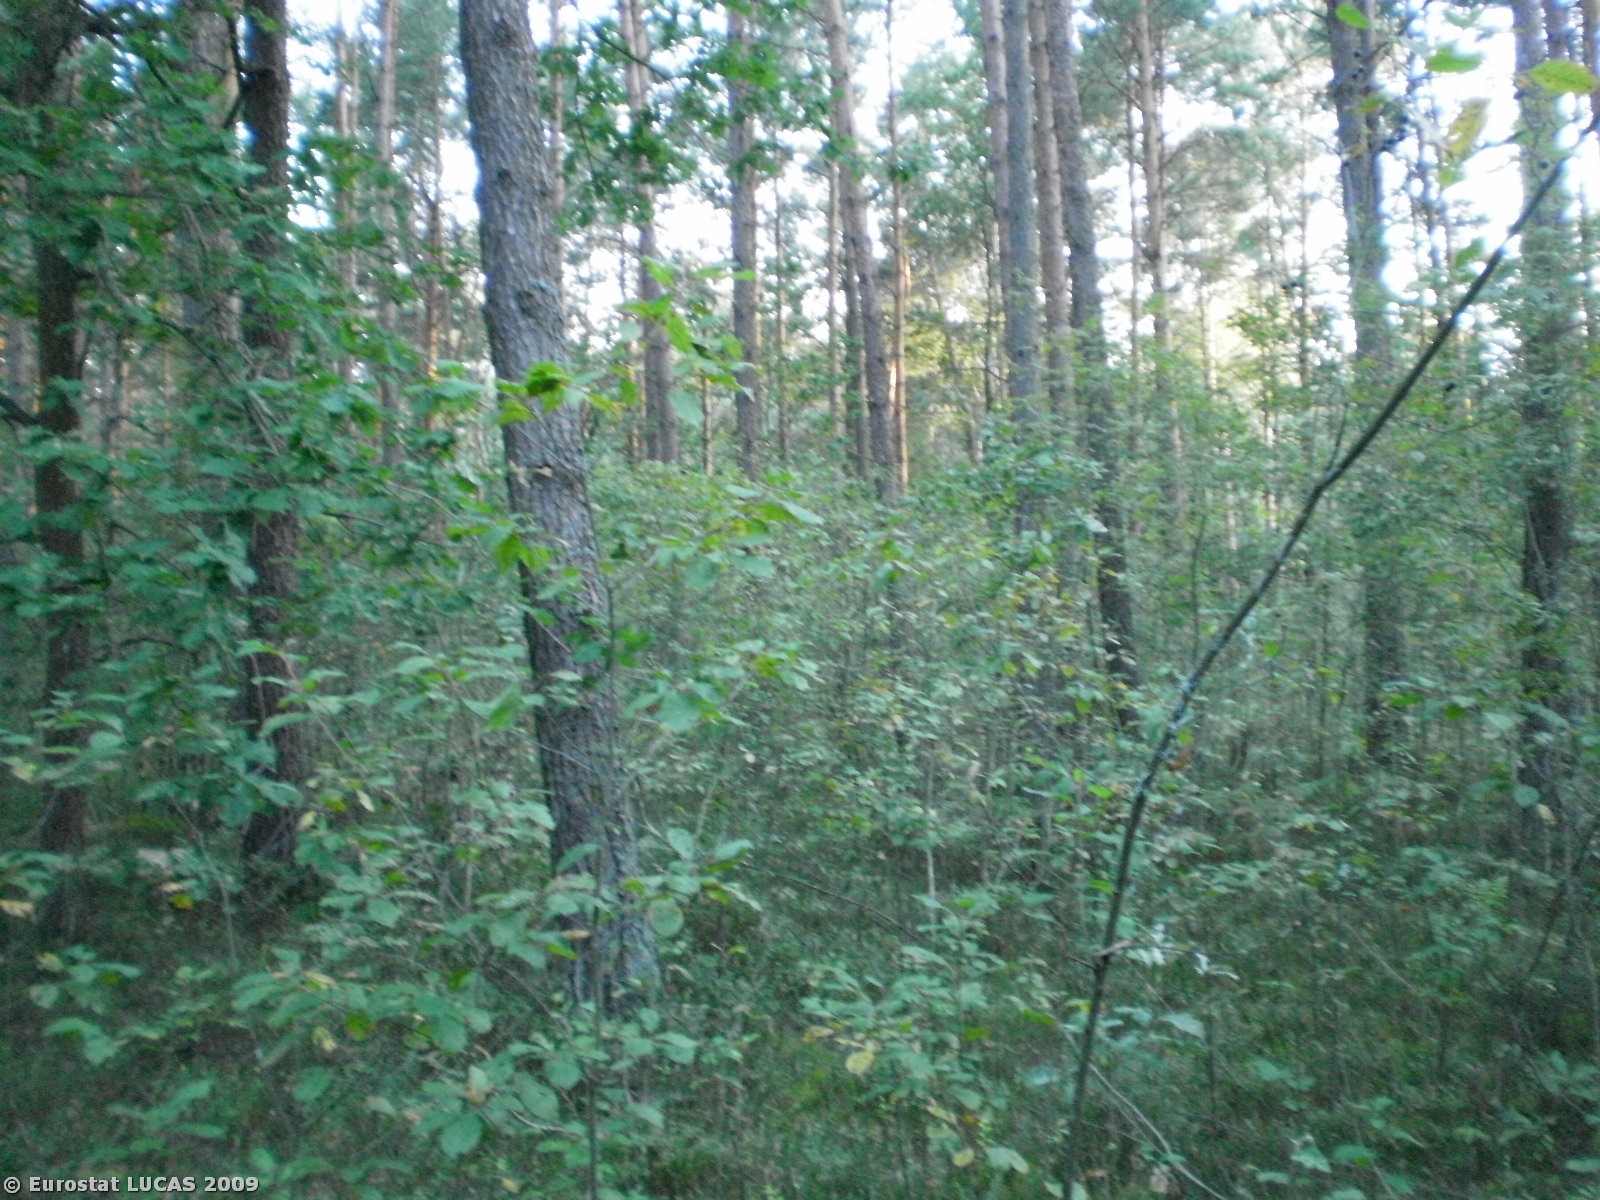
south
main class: Woodland
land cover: Mixed woodland
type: hemiboreal forest and nemoral coniferous forest and mixed broadleaved-coniferous forest
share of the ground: > 75 %
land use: Forestry
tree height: > 5 m
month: August
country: PL
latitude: 52.5931
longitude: 21.7310
